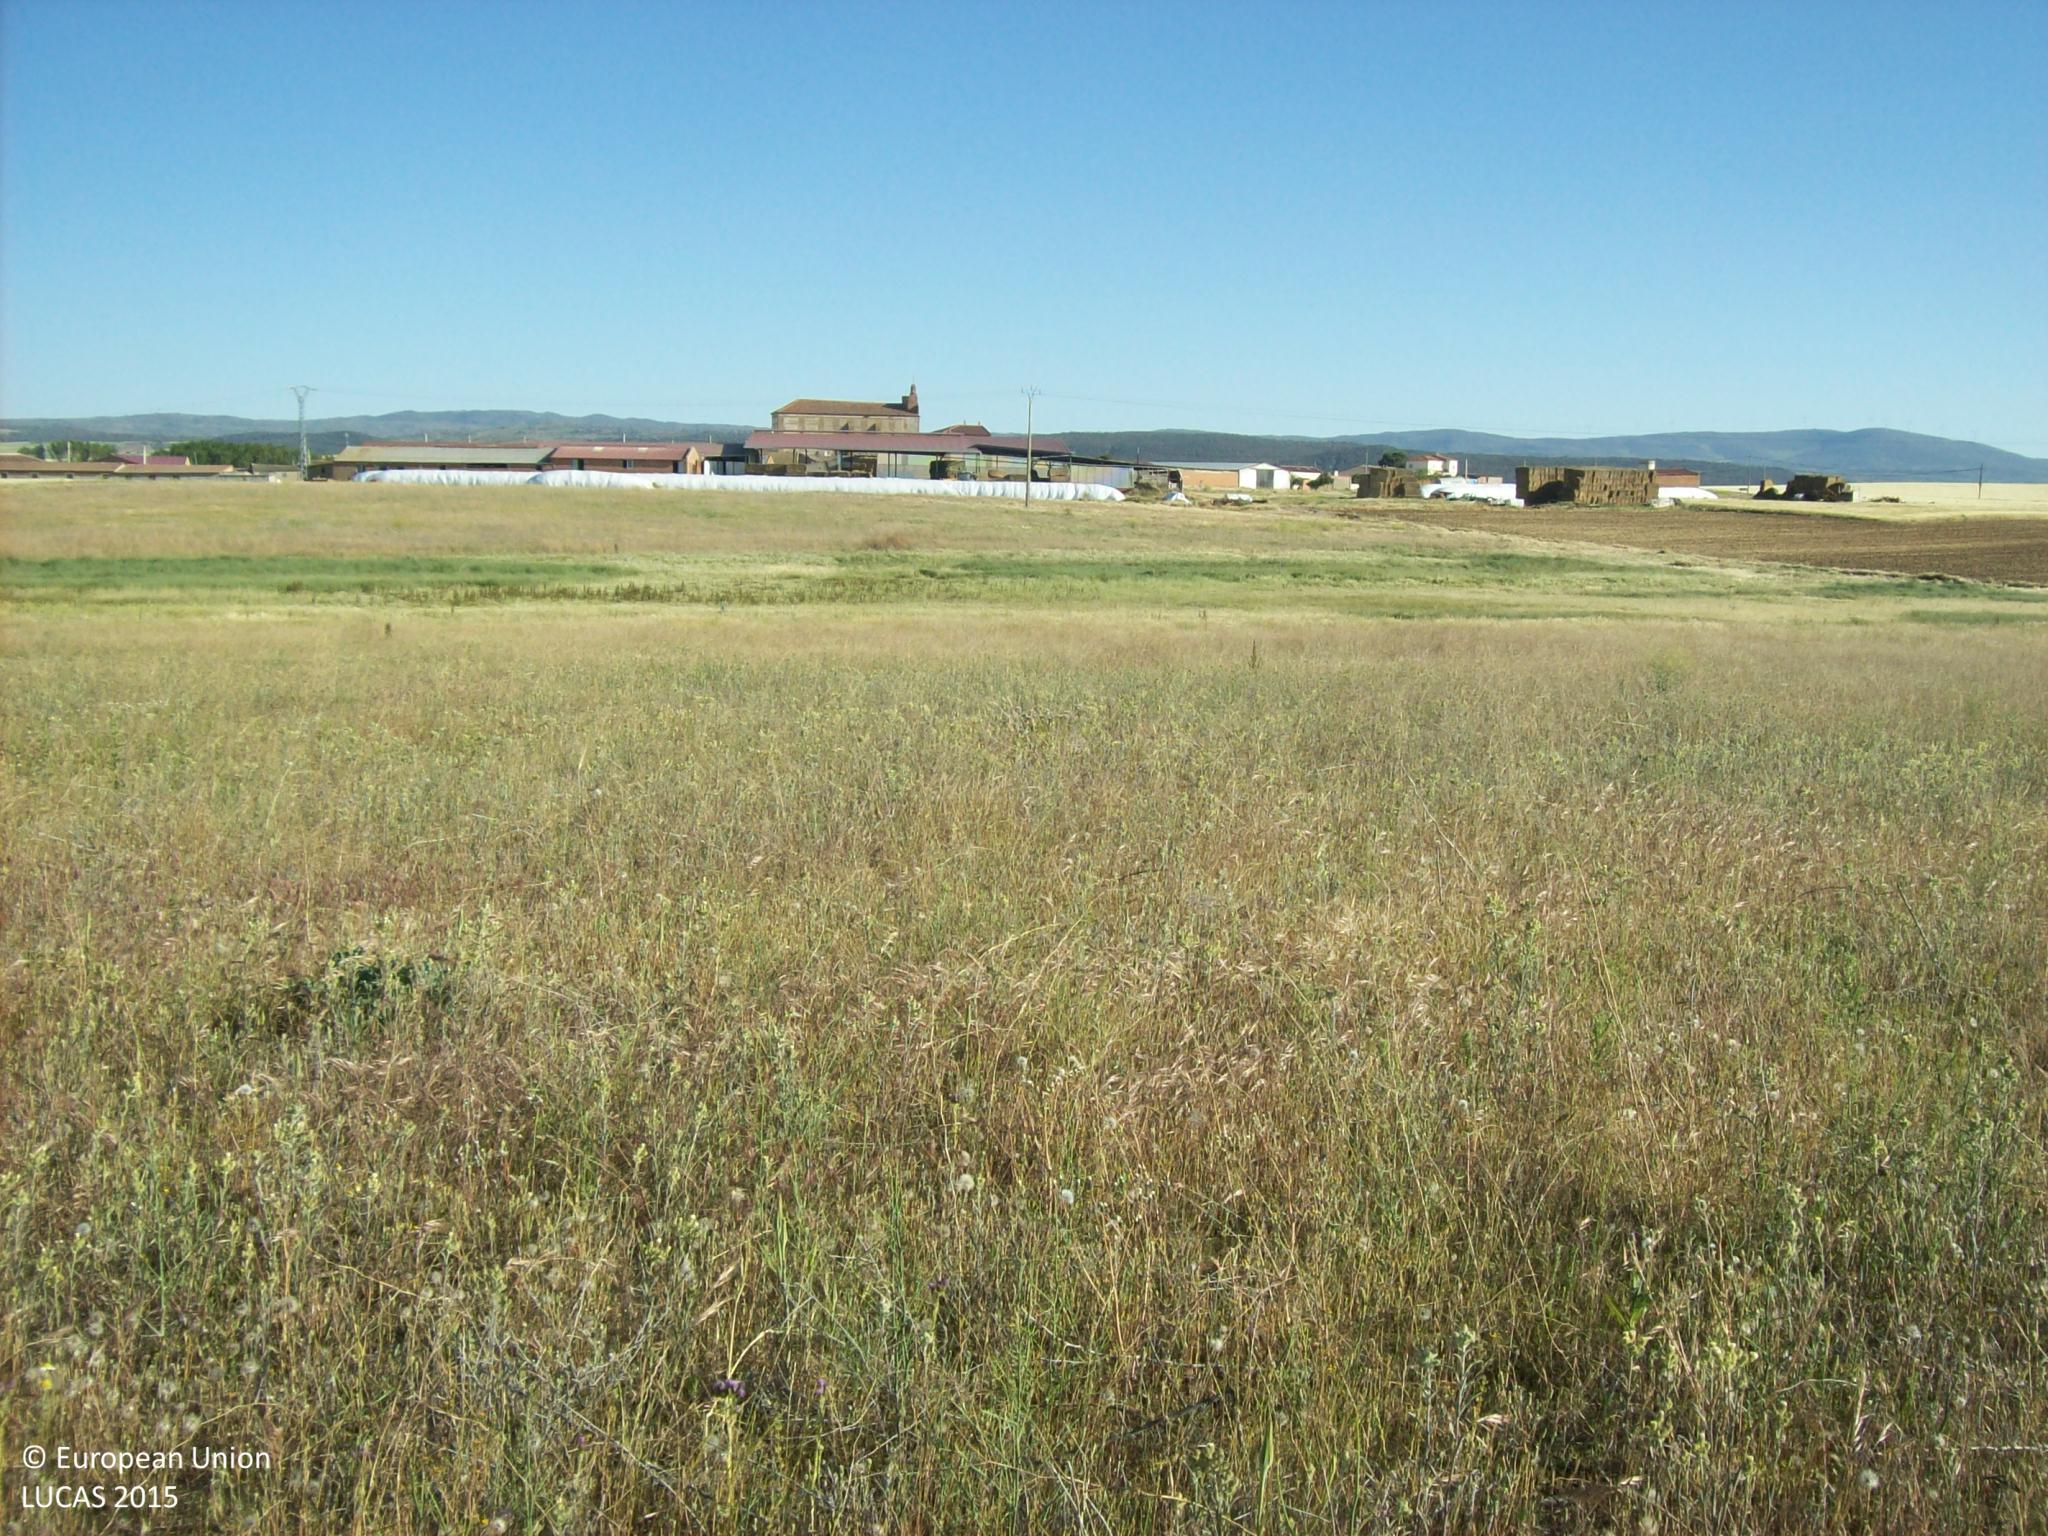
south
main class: Grassland
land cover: Spontaneously vegetated surfaces
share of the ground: > 75 %
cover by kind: herbaceous plants 100 %
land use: Abandoned areas
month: May
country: ES
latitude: 40.7912
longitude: -4.9105
